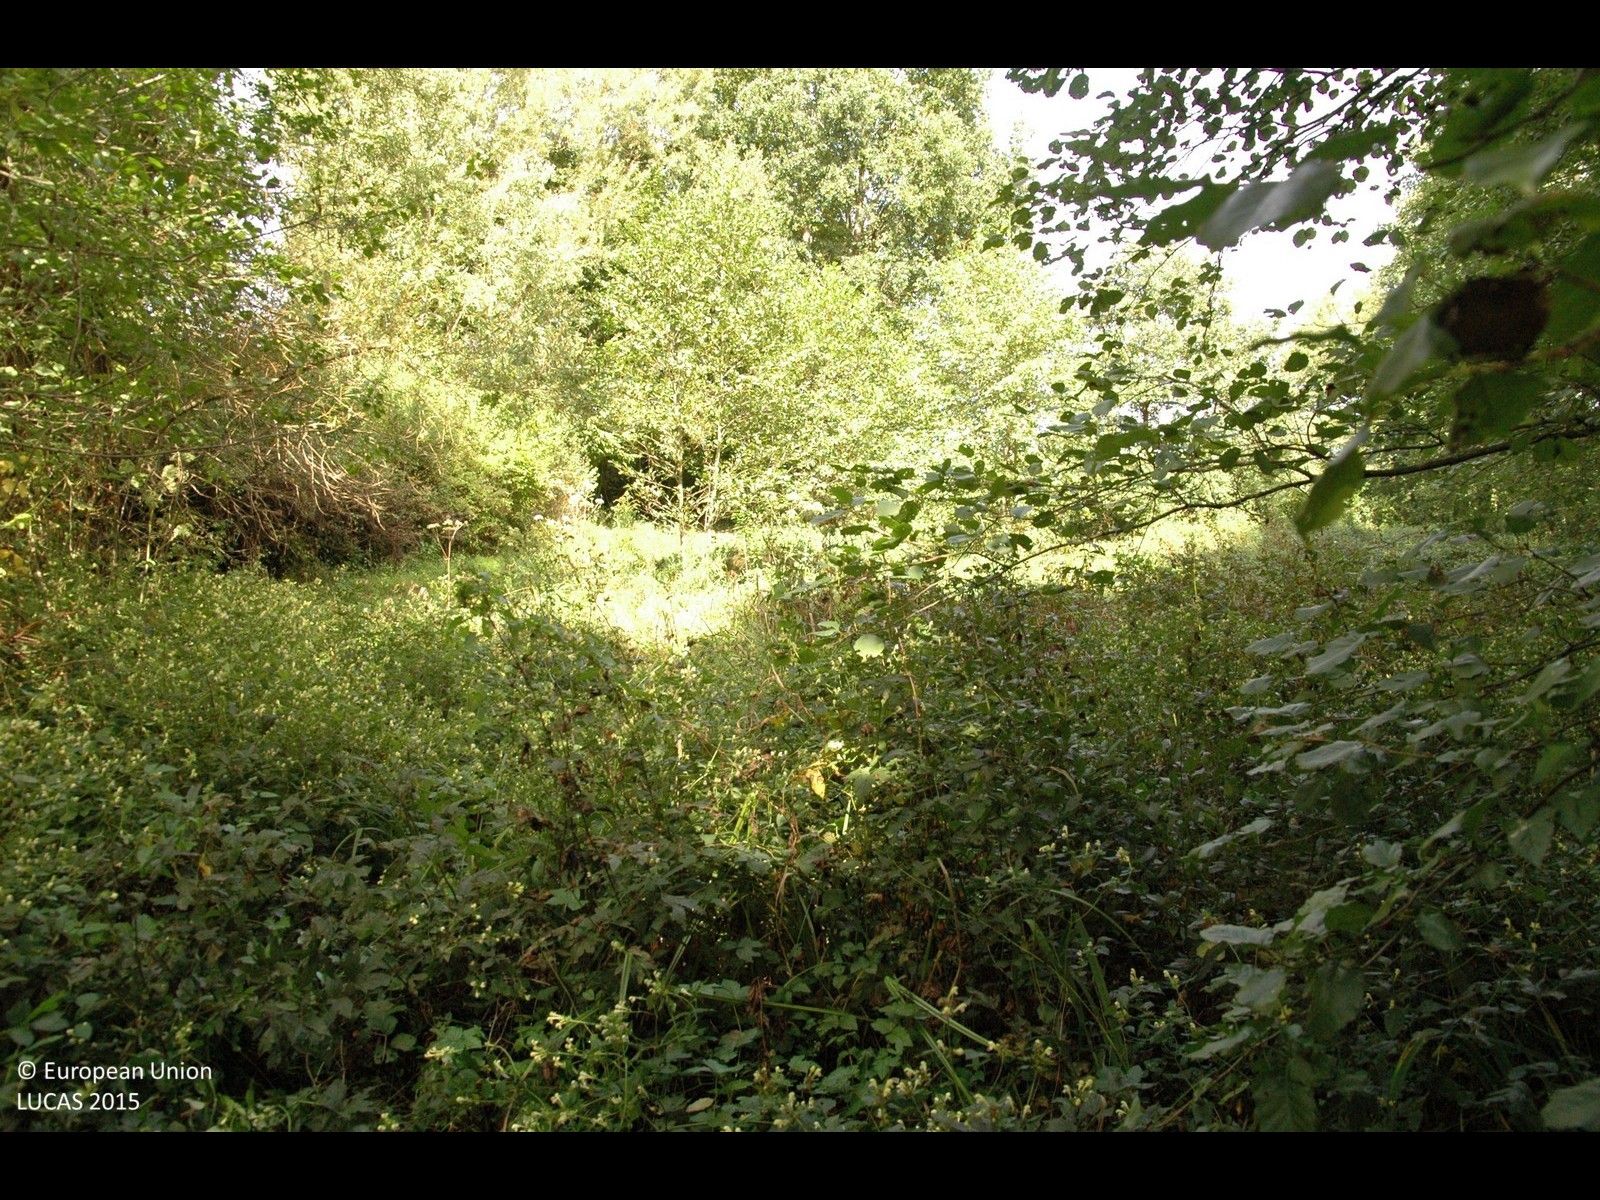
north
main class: Woodland
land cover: Broadleaved woodland
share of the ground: > 75 %
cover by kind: broadleaved forest trees 100 %
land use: Forestry
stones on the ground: < 10 %
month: September
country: HR
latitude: 45.5711
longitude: 15.9556
